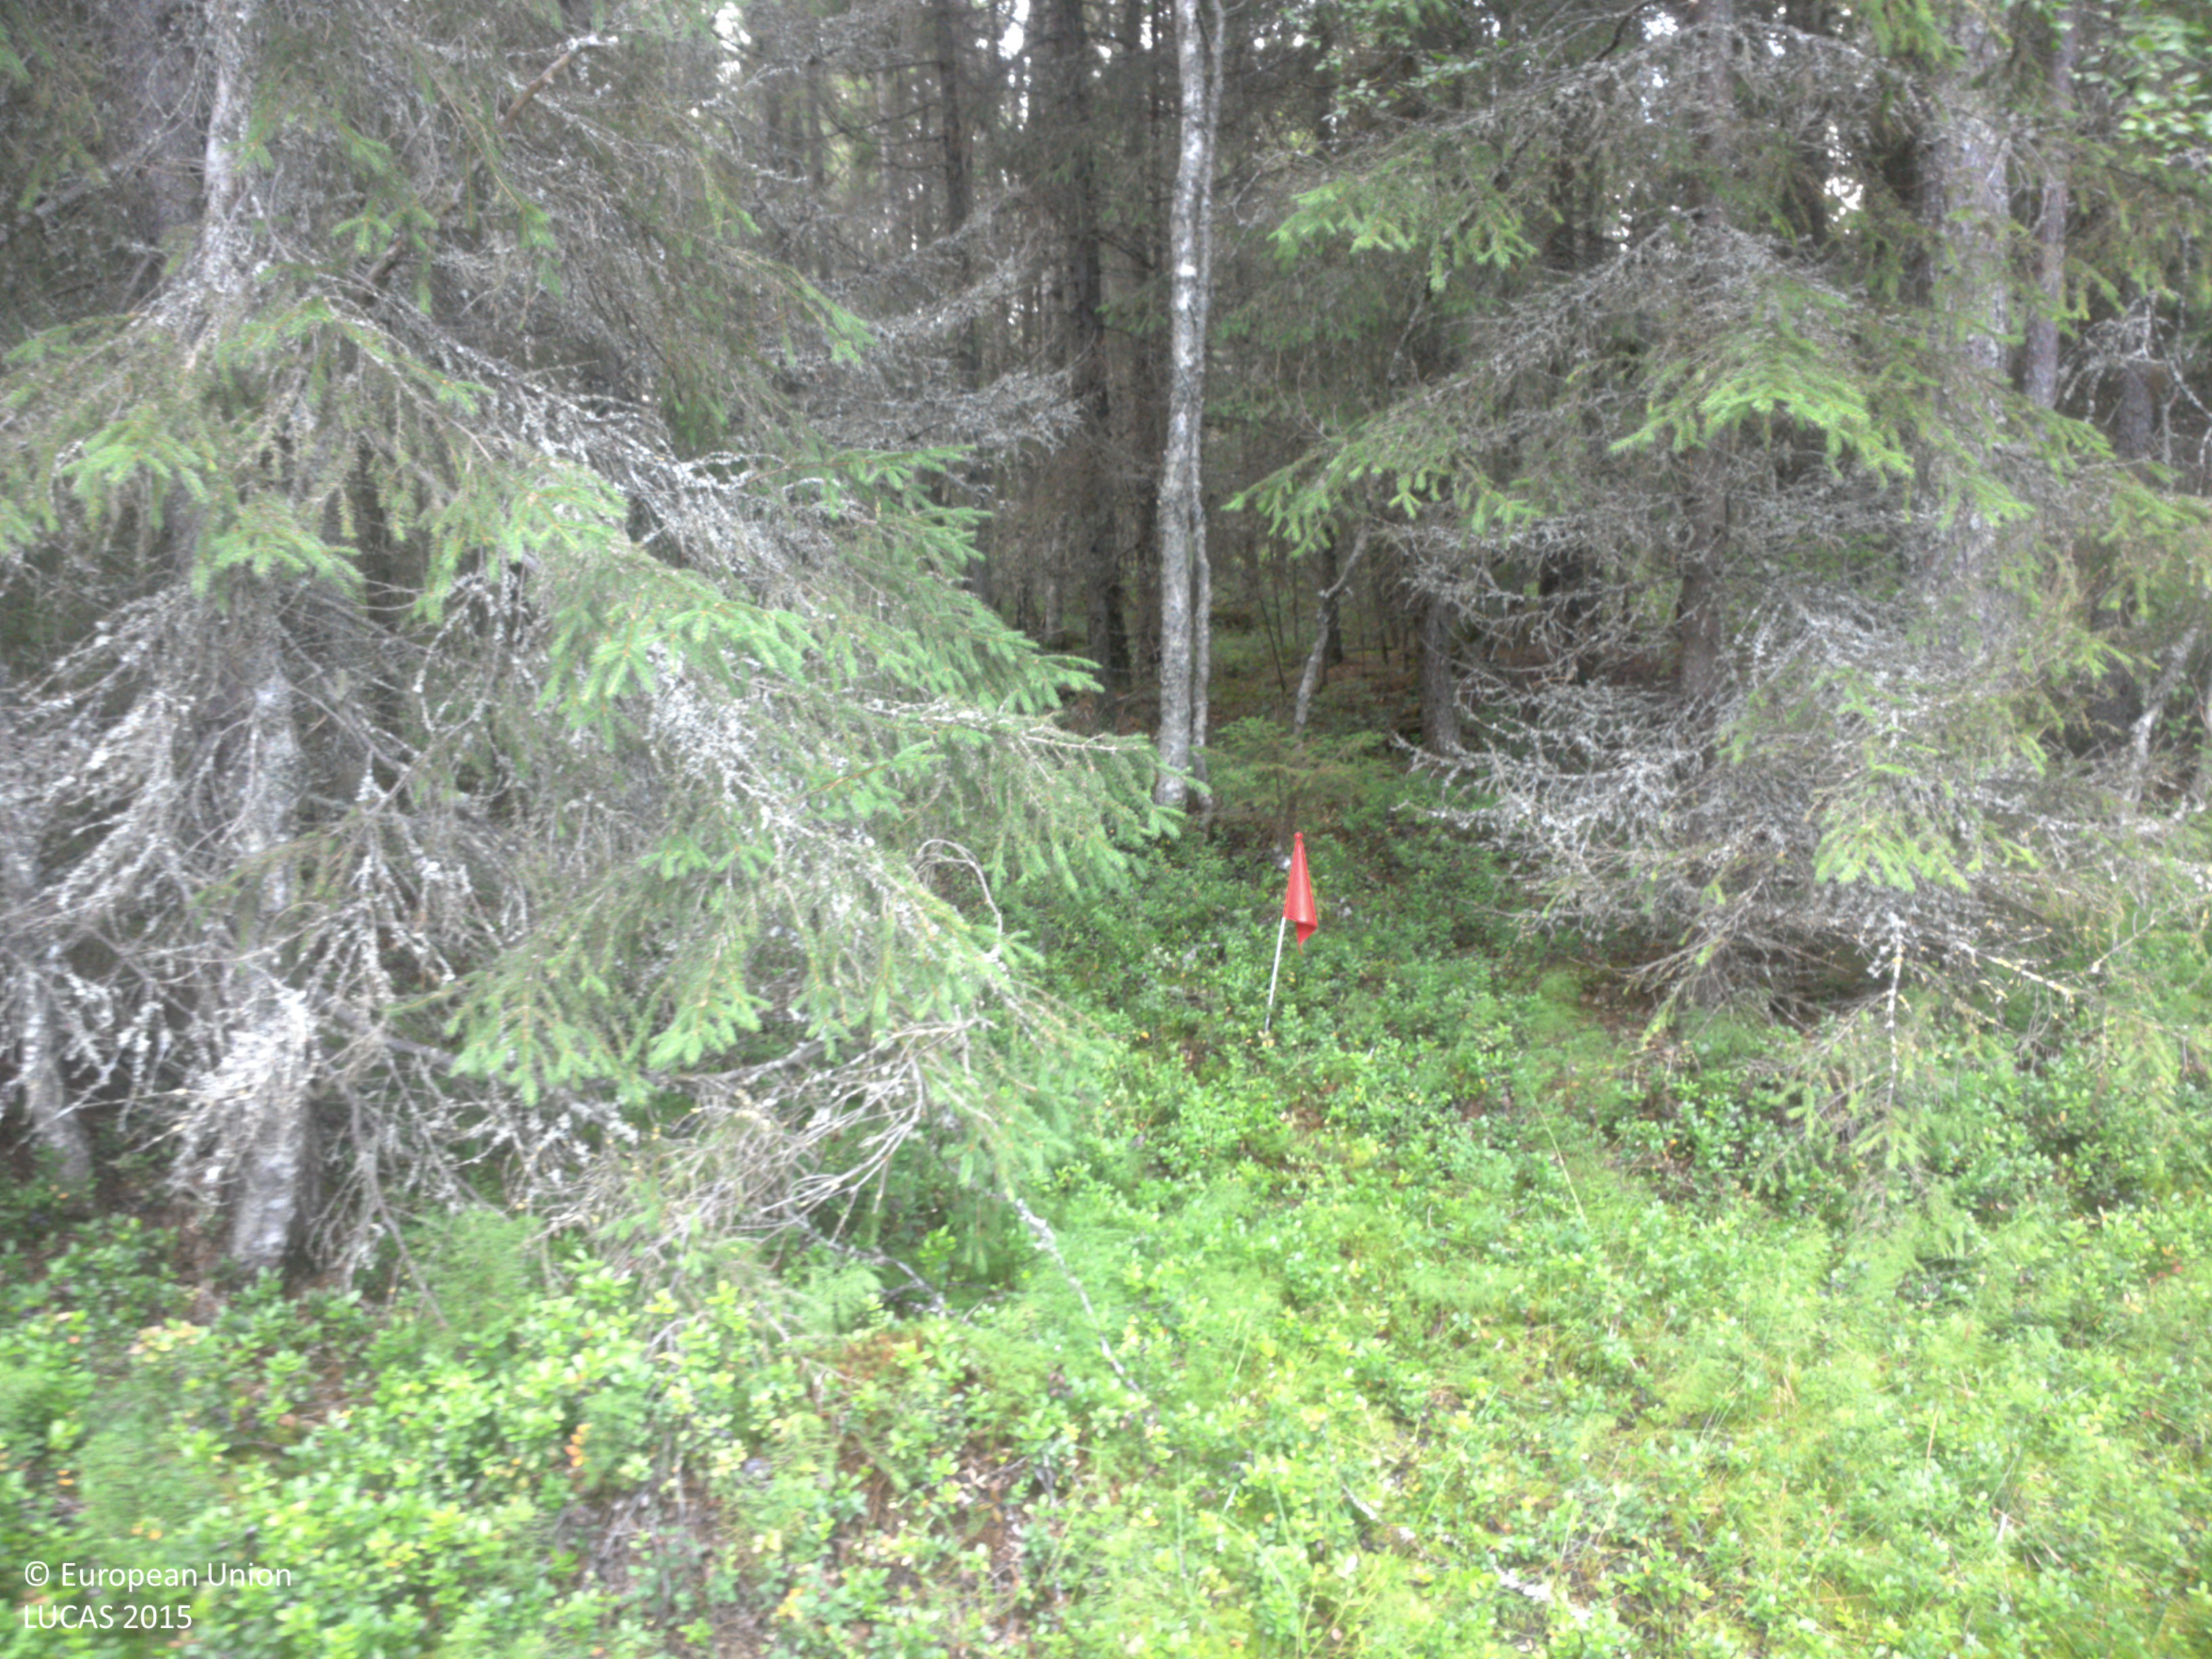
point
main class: Woodland
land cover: Other mixed woodland
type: boreal forest
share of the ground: 50 - 75 %
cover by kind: coniferous forest trees 40 %, broadleaved forest trees 20 %, shrubs 20 %, herbaceous plants 20 %
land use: Forestry
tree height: > 5 m
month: July
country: SE
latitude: 63.4822
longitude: 19.3950
